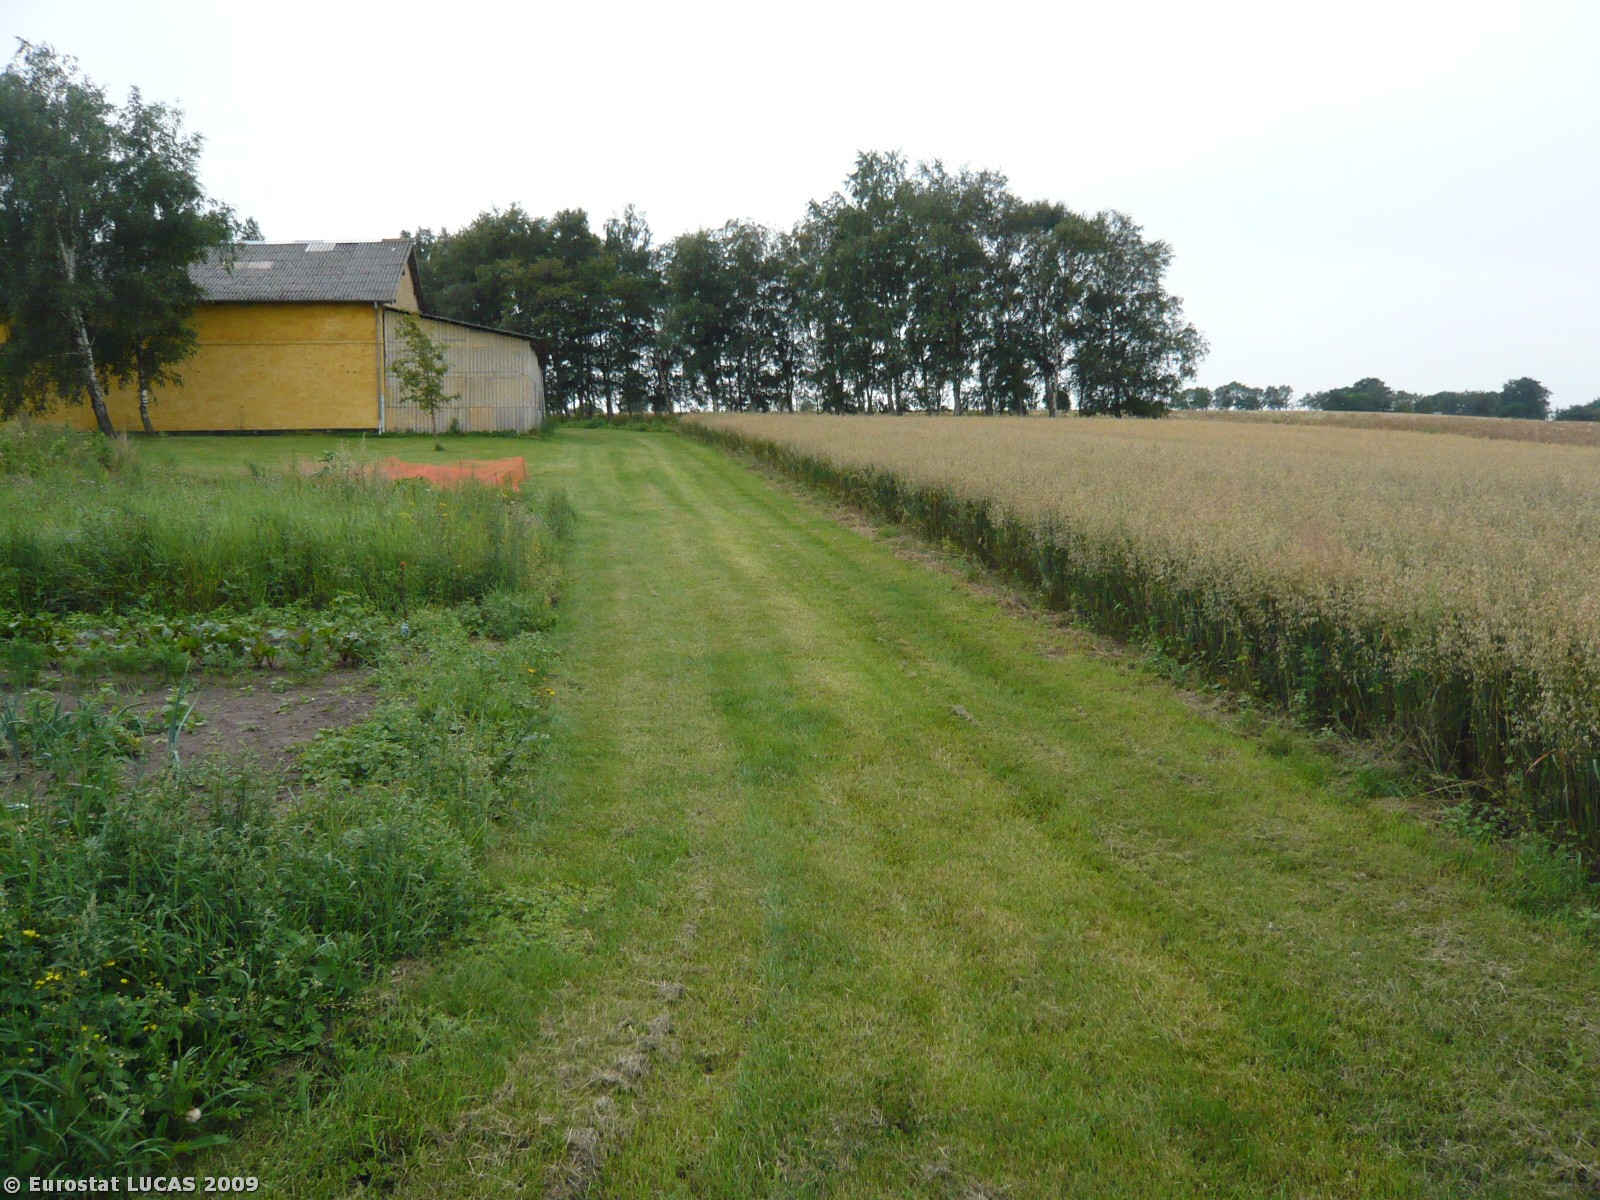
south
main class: Cropland
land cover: Oats
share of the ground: > 75 %
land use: Agriculture (excluding fallow land and kitchen gardens)
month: July
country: DK
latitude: 55.7377
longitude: 12.1801
